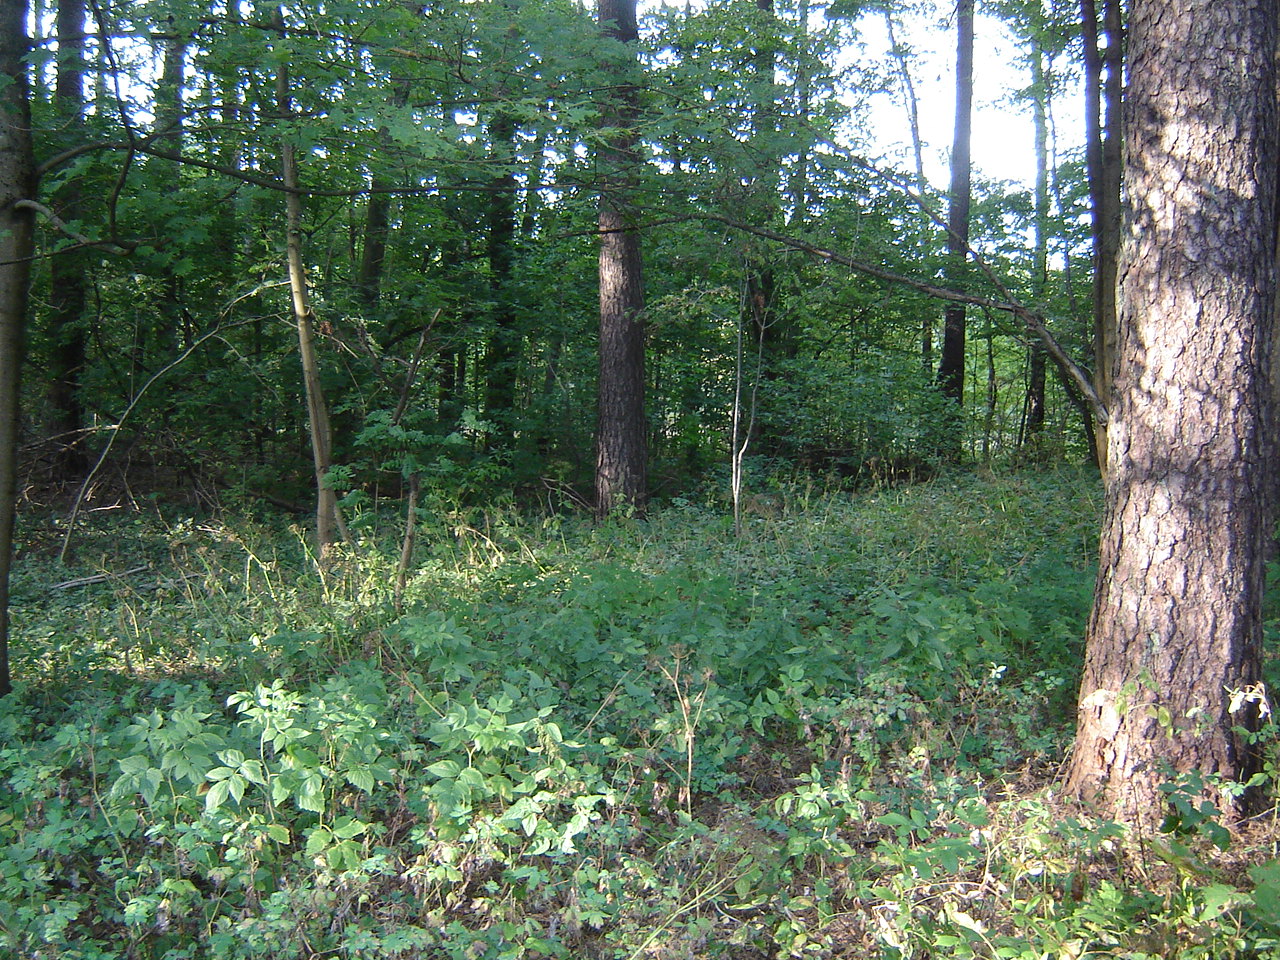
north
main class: Woodland
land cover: Pine dominated mixed woodland
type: hemiboreal forest and nemoral coniferous forest and mixed broadleaved-coniferous forest
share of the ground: > 75 %
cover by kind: coniferous forest trees 55 %, broadleaved forest trees 30 %, herbaceous plants 15 %
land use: Forestry
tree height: > 5 m
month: August
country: LT
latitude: 54.6125
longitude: 25.2167
